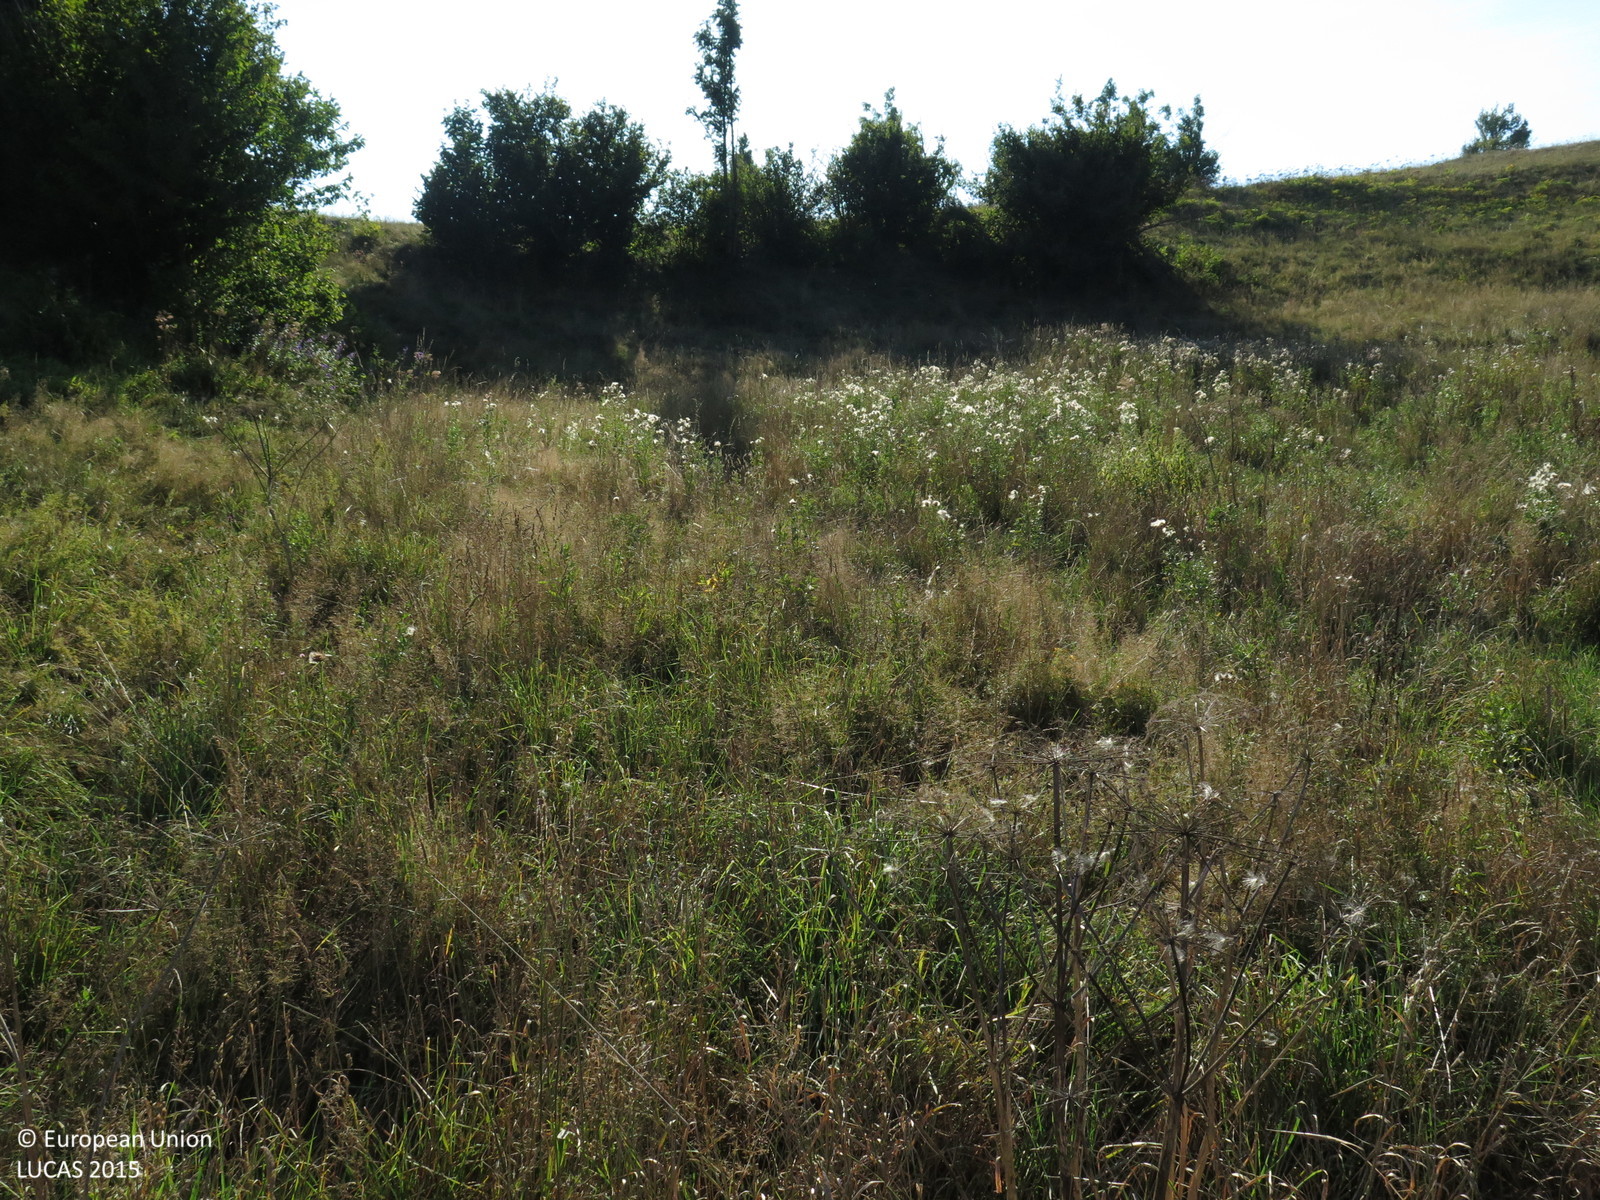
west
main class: Grassland
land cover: Grassland without tree/shrub cover
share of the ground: > 75 %
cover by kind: herbaceous plants 95 %, shrubs 5 %
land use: Agriculture (excluding fallow land and kitchen gardens)
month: August
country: HR
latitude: 45.3205
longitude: 14.8556
